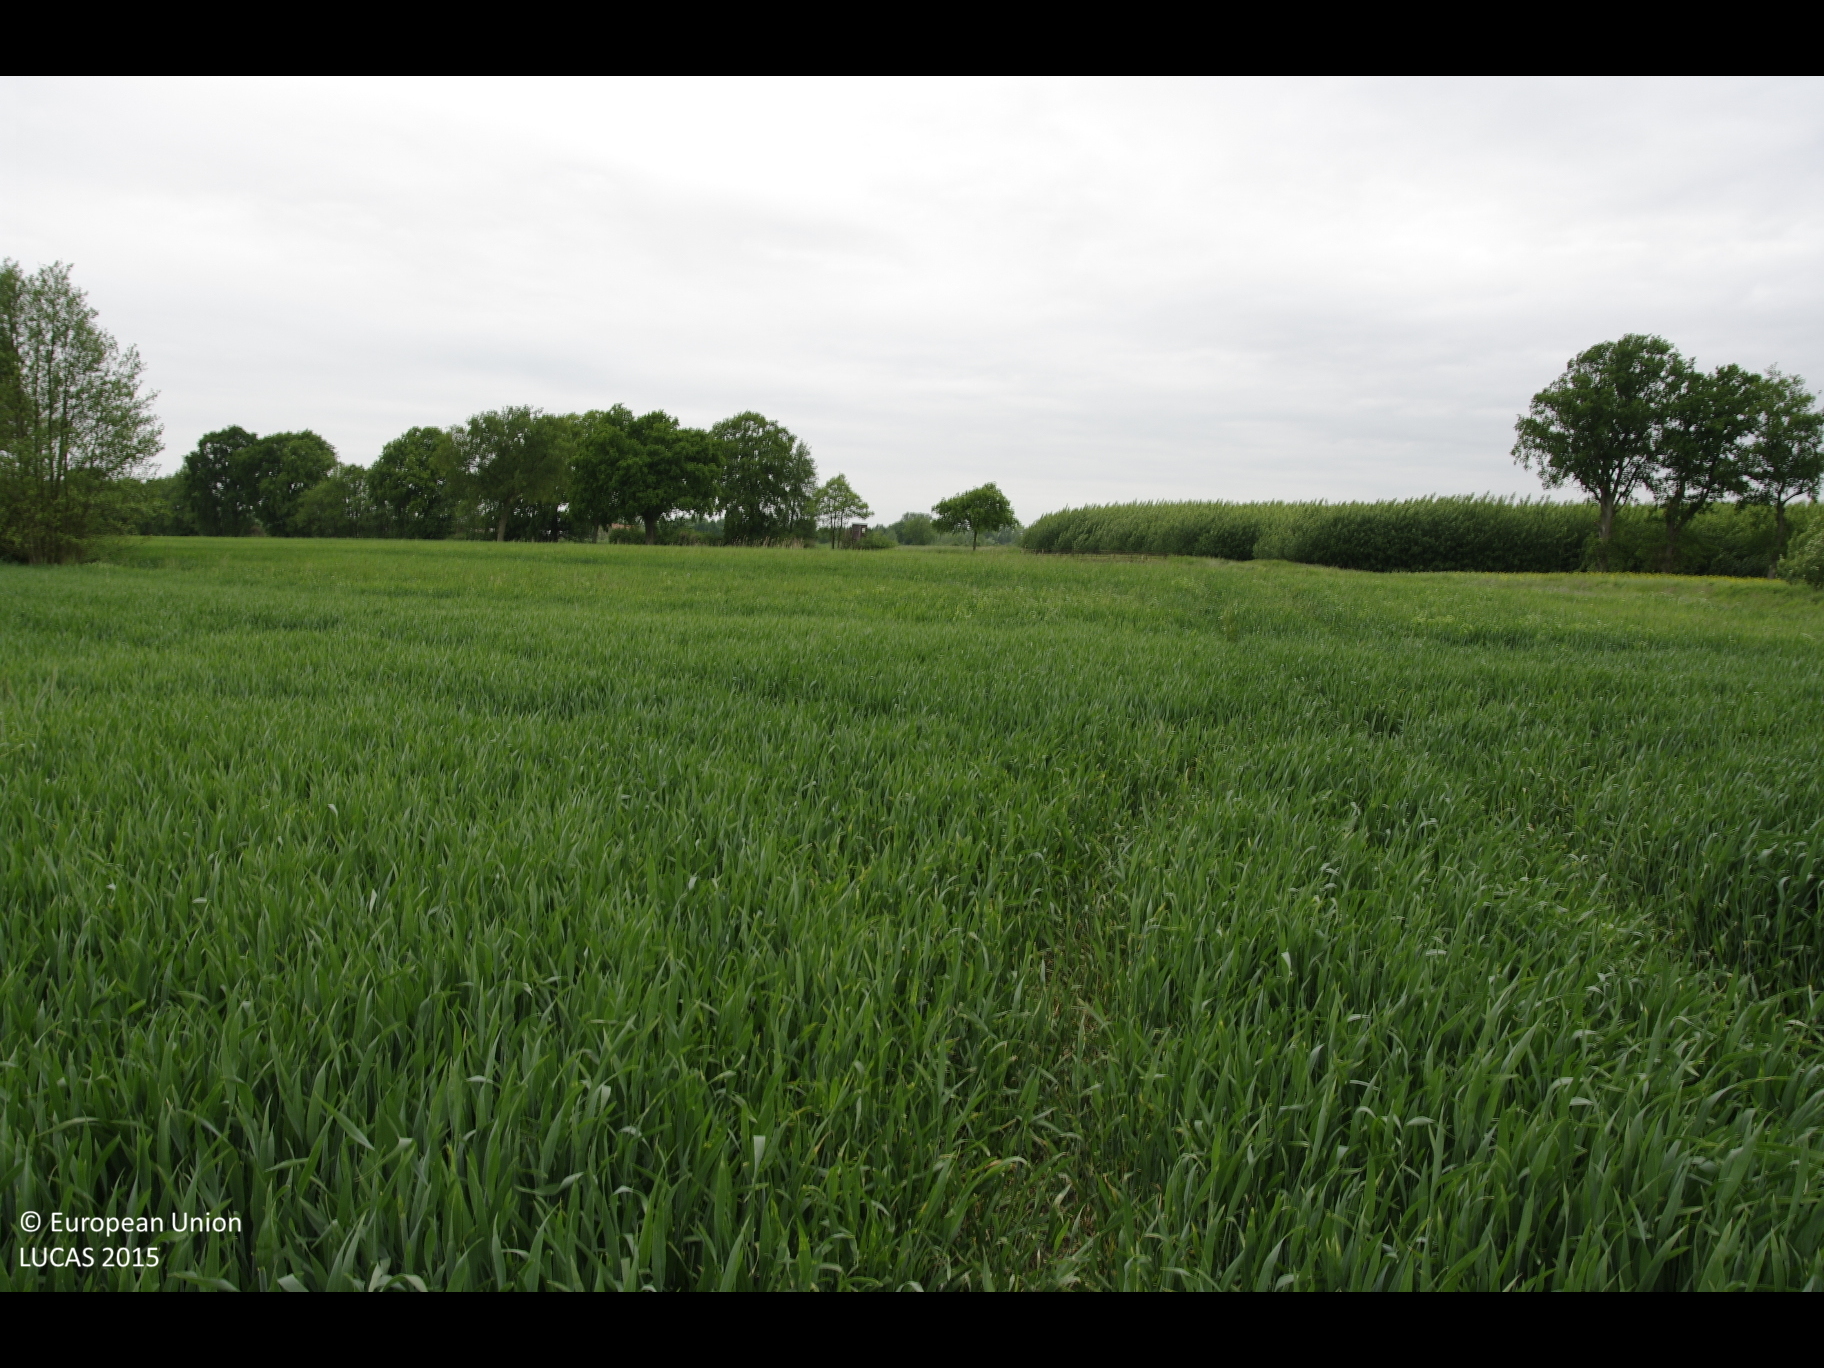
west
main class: Cropland
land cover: Common wheat
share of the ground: > 75 %
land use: Agriculture (excluding fallow land and kitchen gardens)
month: June
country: DE
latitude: 53.3464
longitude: 10.6156
